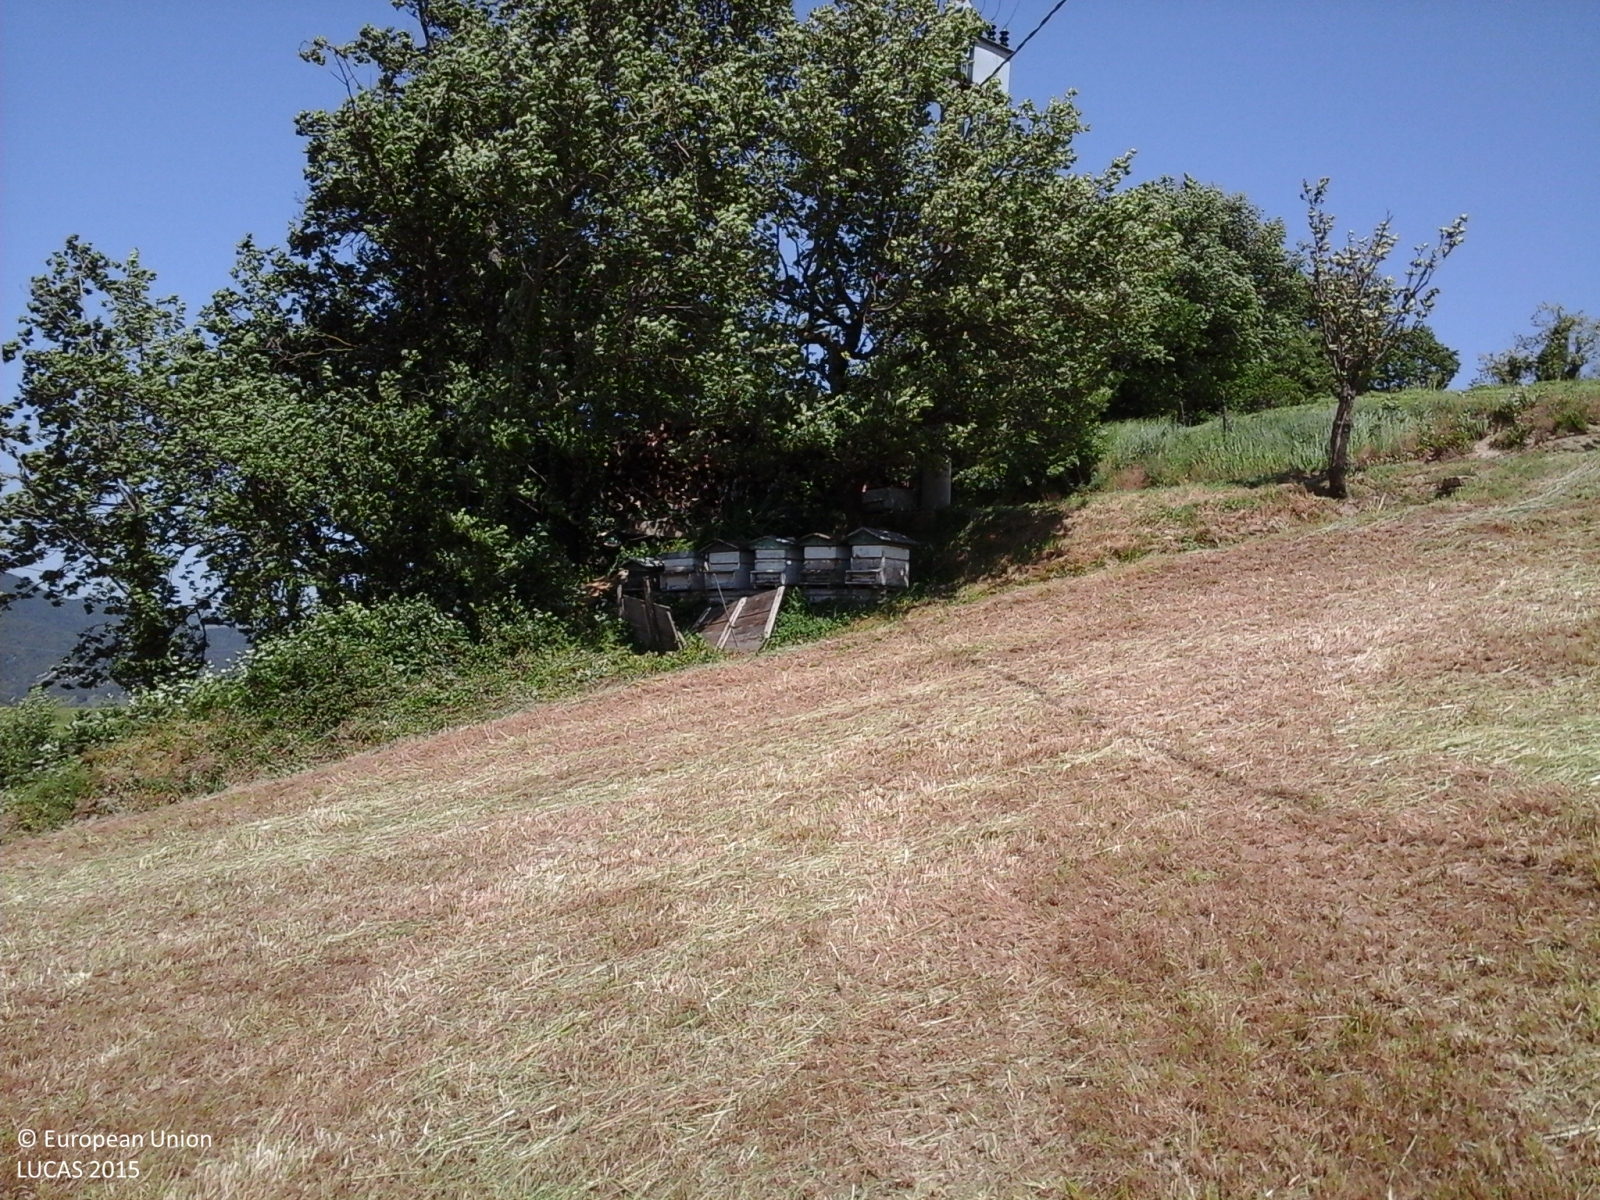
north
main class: Cropland
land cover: Lucerne
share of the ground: > 75 %
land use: Agriculture (excluding fallow land and kitchen gardens)
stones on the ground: < 10 %
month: May
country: IT
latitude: 44.0633
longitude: 11.8557
